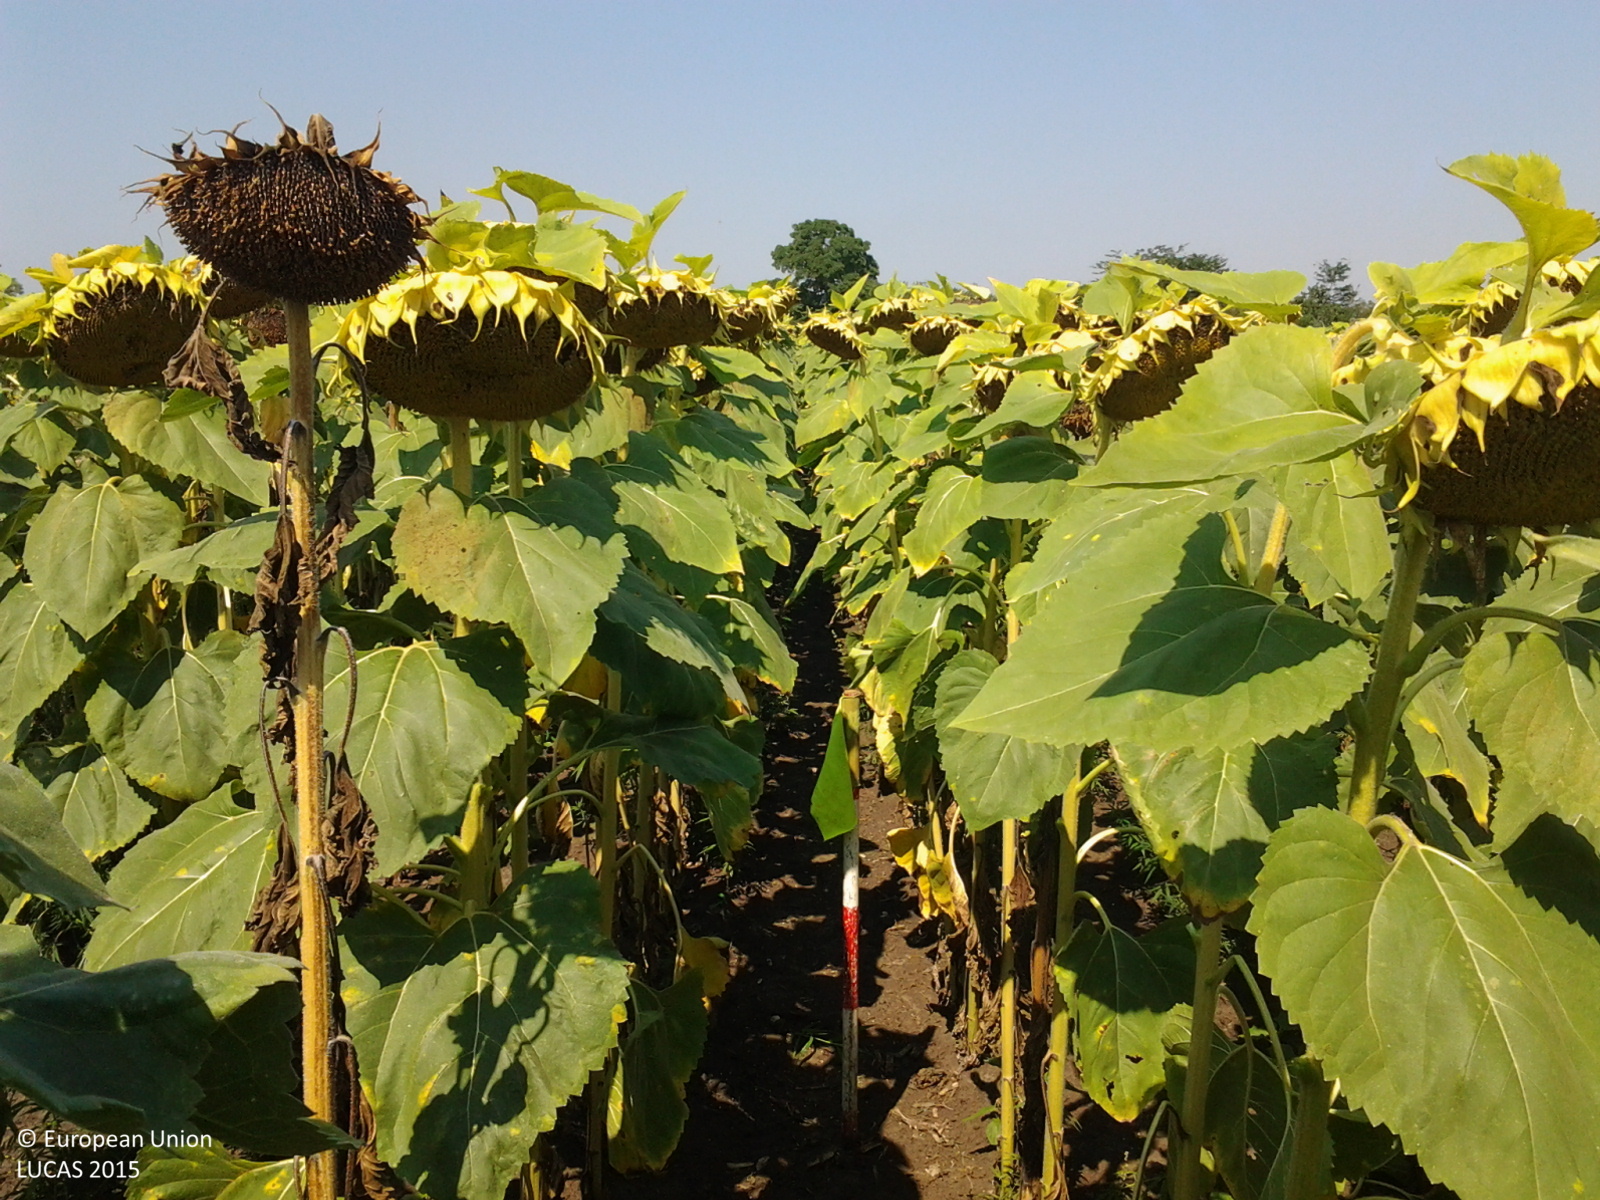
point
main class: Cropland
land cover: Sunflower
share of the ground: > 75 %
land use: Agriculture (excluding fallow land and kitchen gardens)
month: August
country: HU
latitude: 47.3051
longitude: 19.9045
